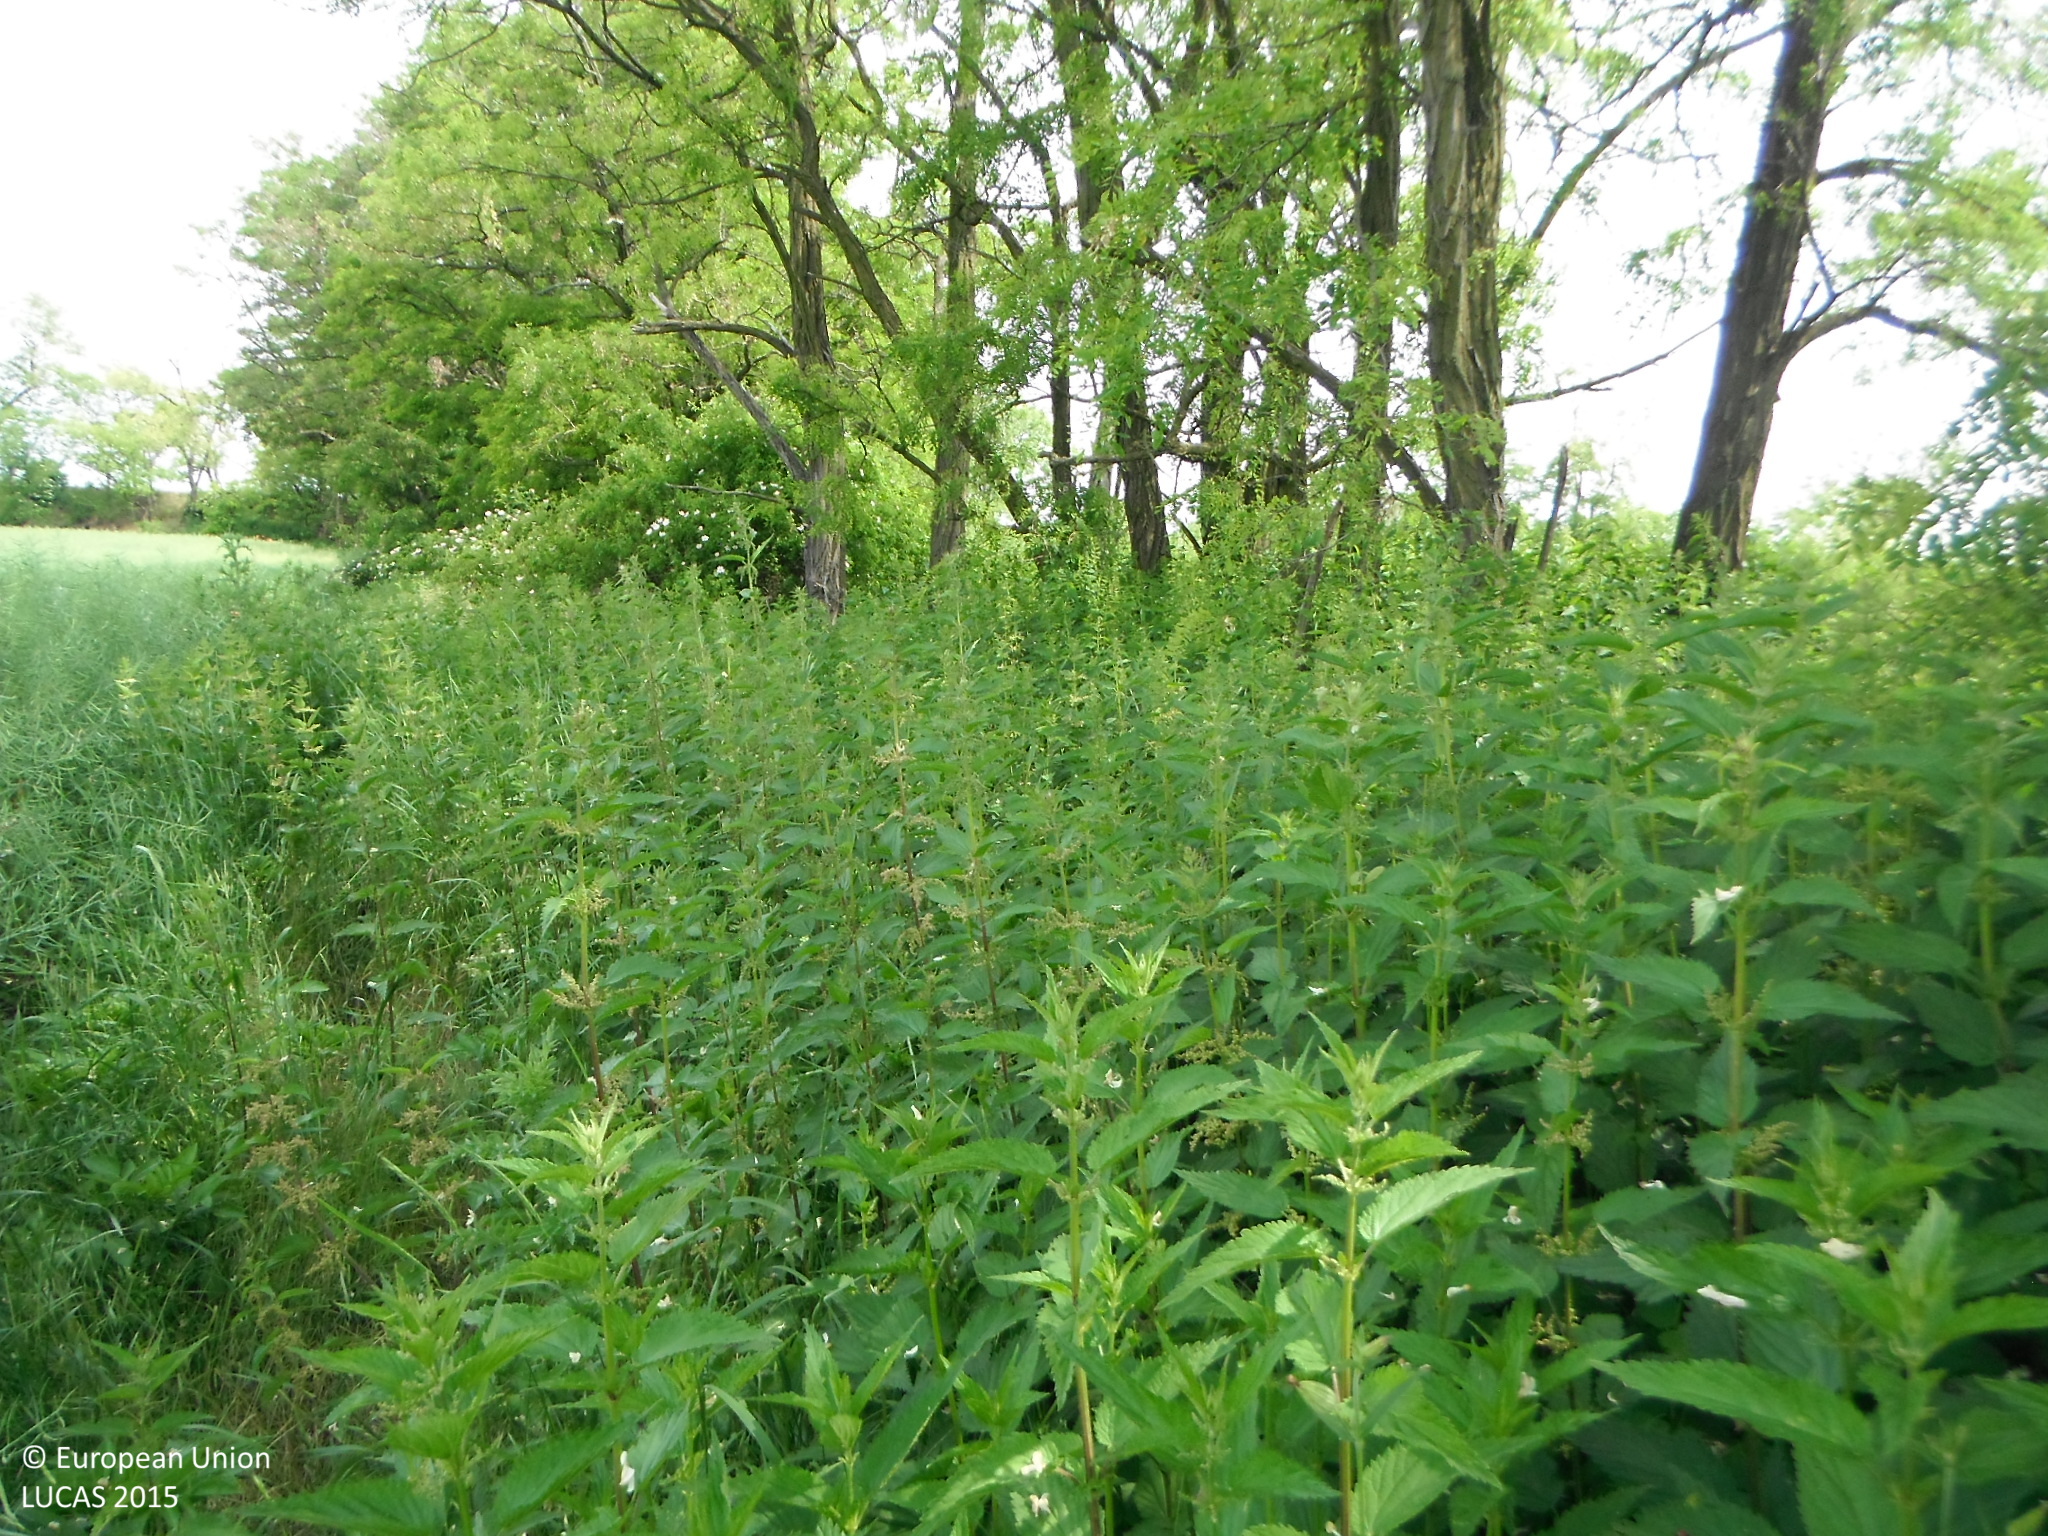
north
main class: Cropland
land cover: Rape and turnip rape
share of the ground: > 75 %
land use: Agriculture (excluding fallow land and kitchen gardens)
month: June
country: SK
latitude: 48.2381
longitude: 18.2684
